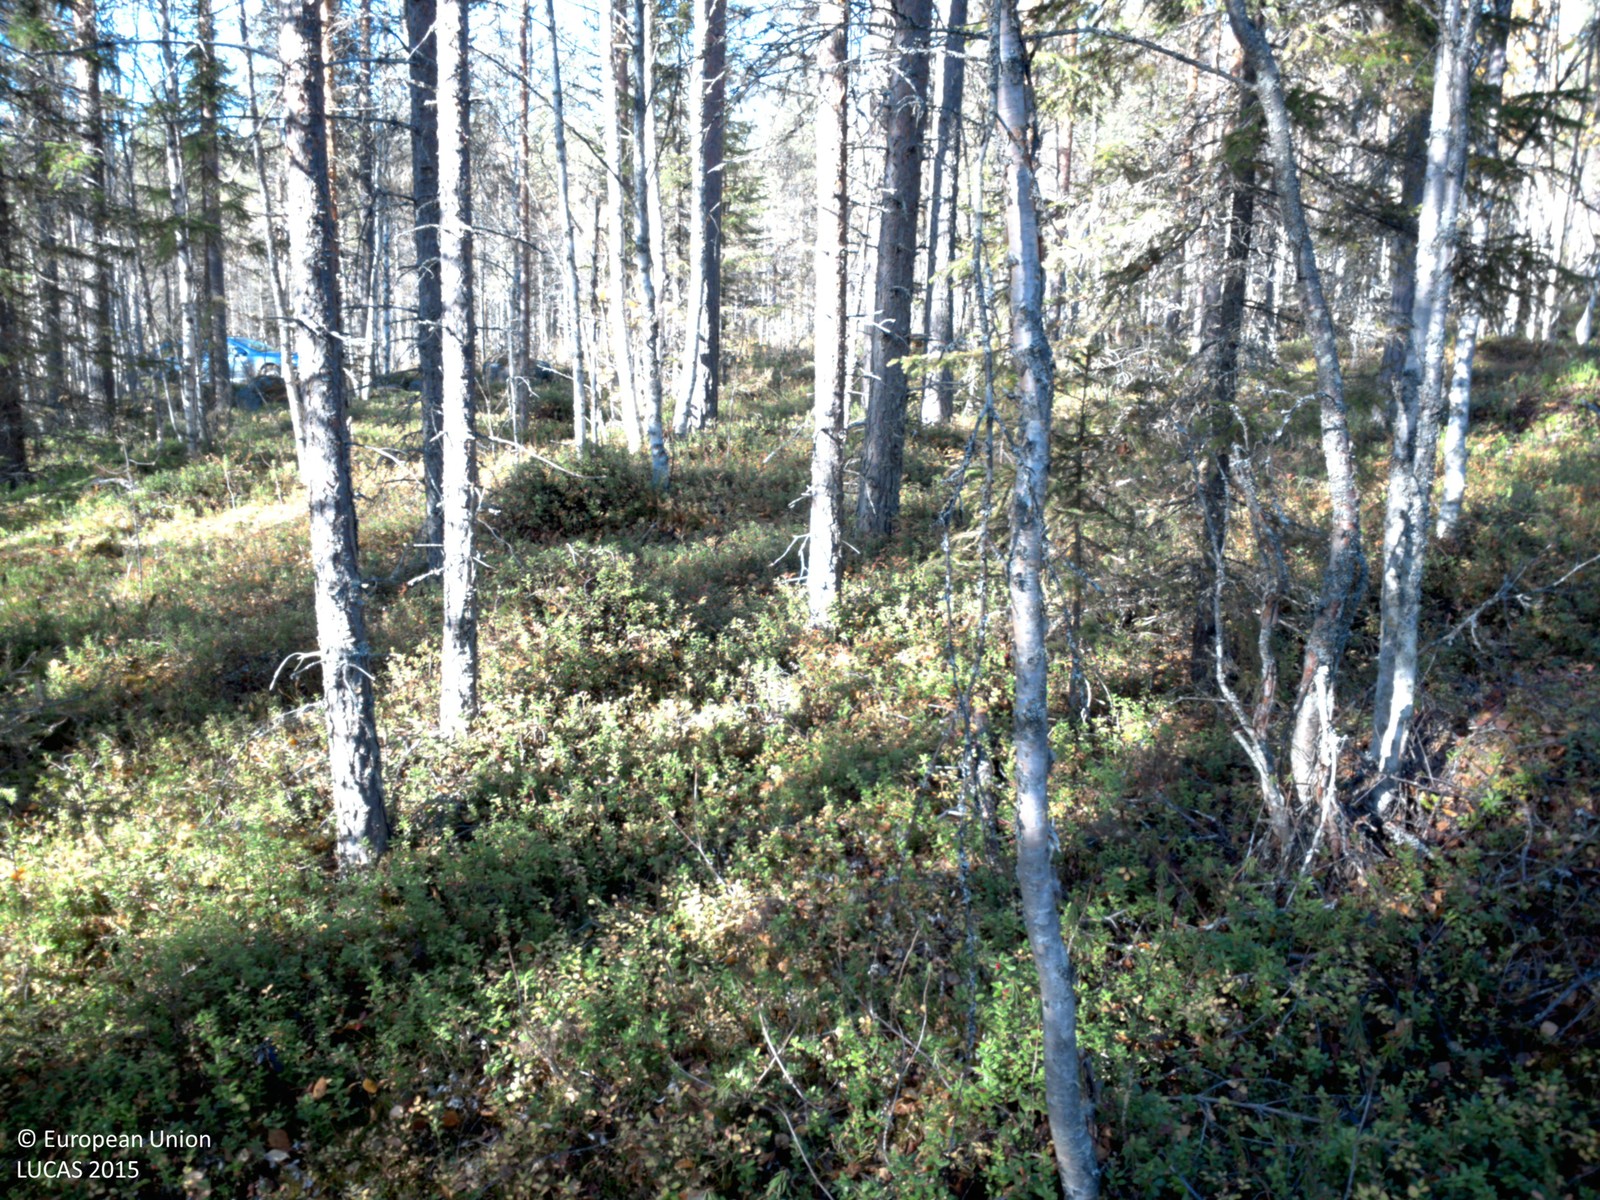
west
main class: Woodland
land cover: Pine dominated mixed woodland
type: boreal forest
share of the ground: 50 - 75 %
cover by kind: coniferous forest trees 45 %, shrubs 35 %, broadleaved forest trees 15 %, lichens and mosses 5 %
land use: Forestry
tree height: > 5 m
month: September
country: SE
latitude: 64.8606
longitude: 18.5097
